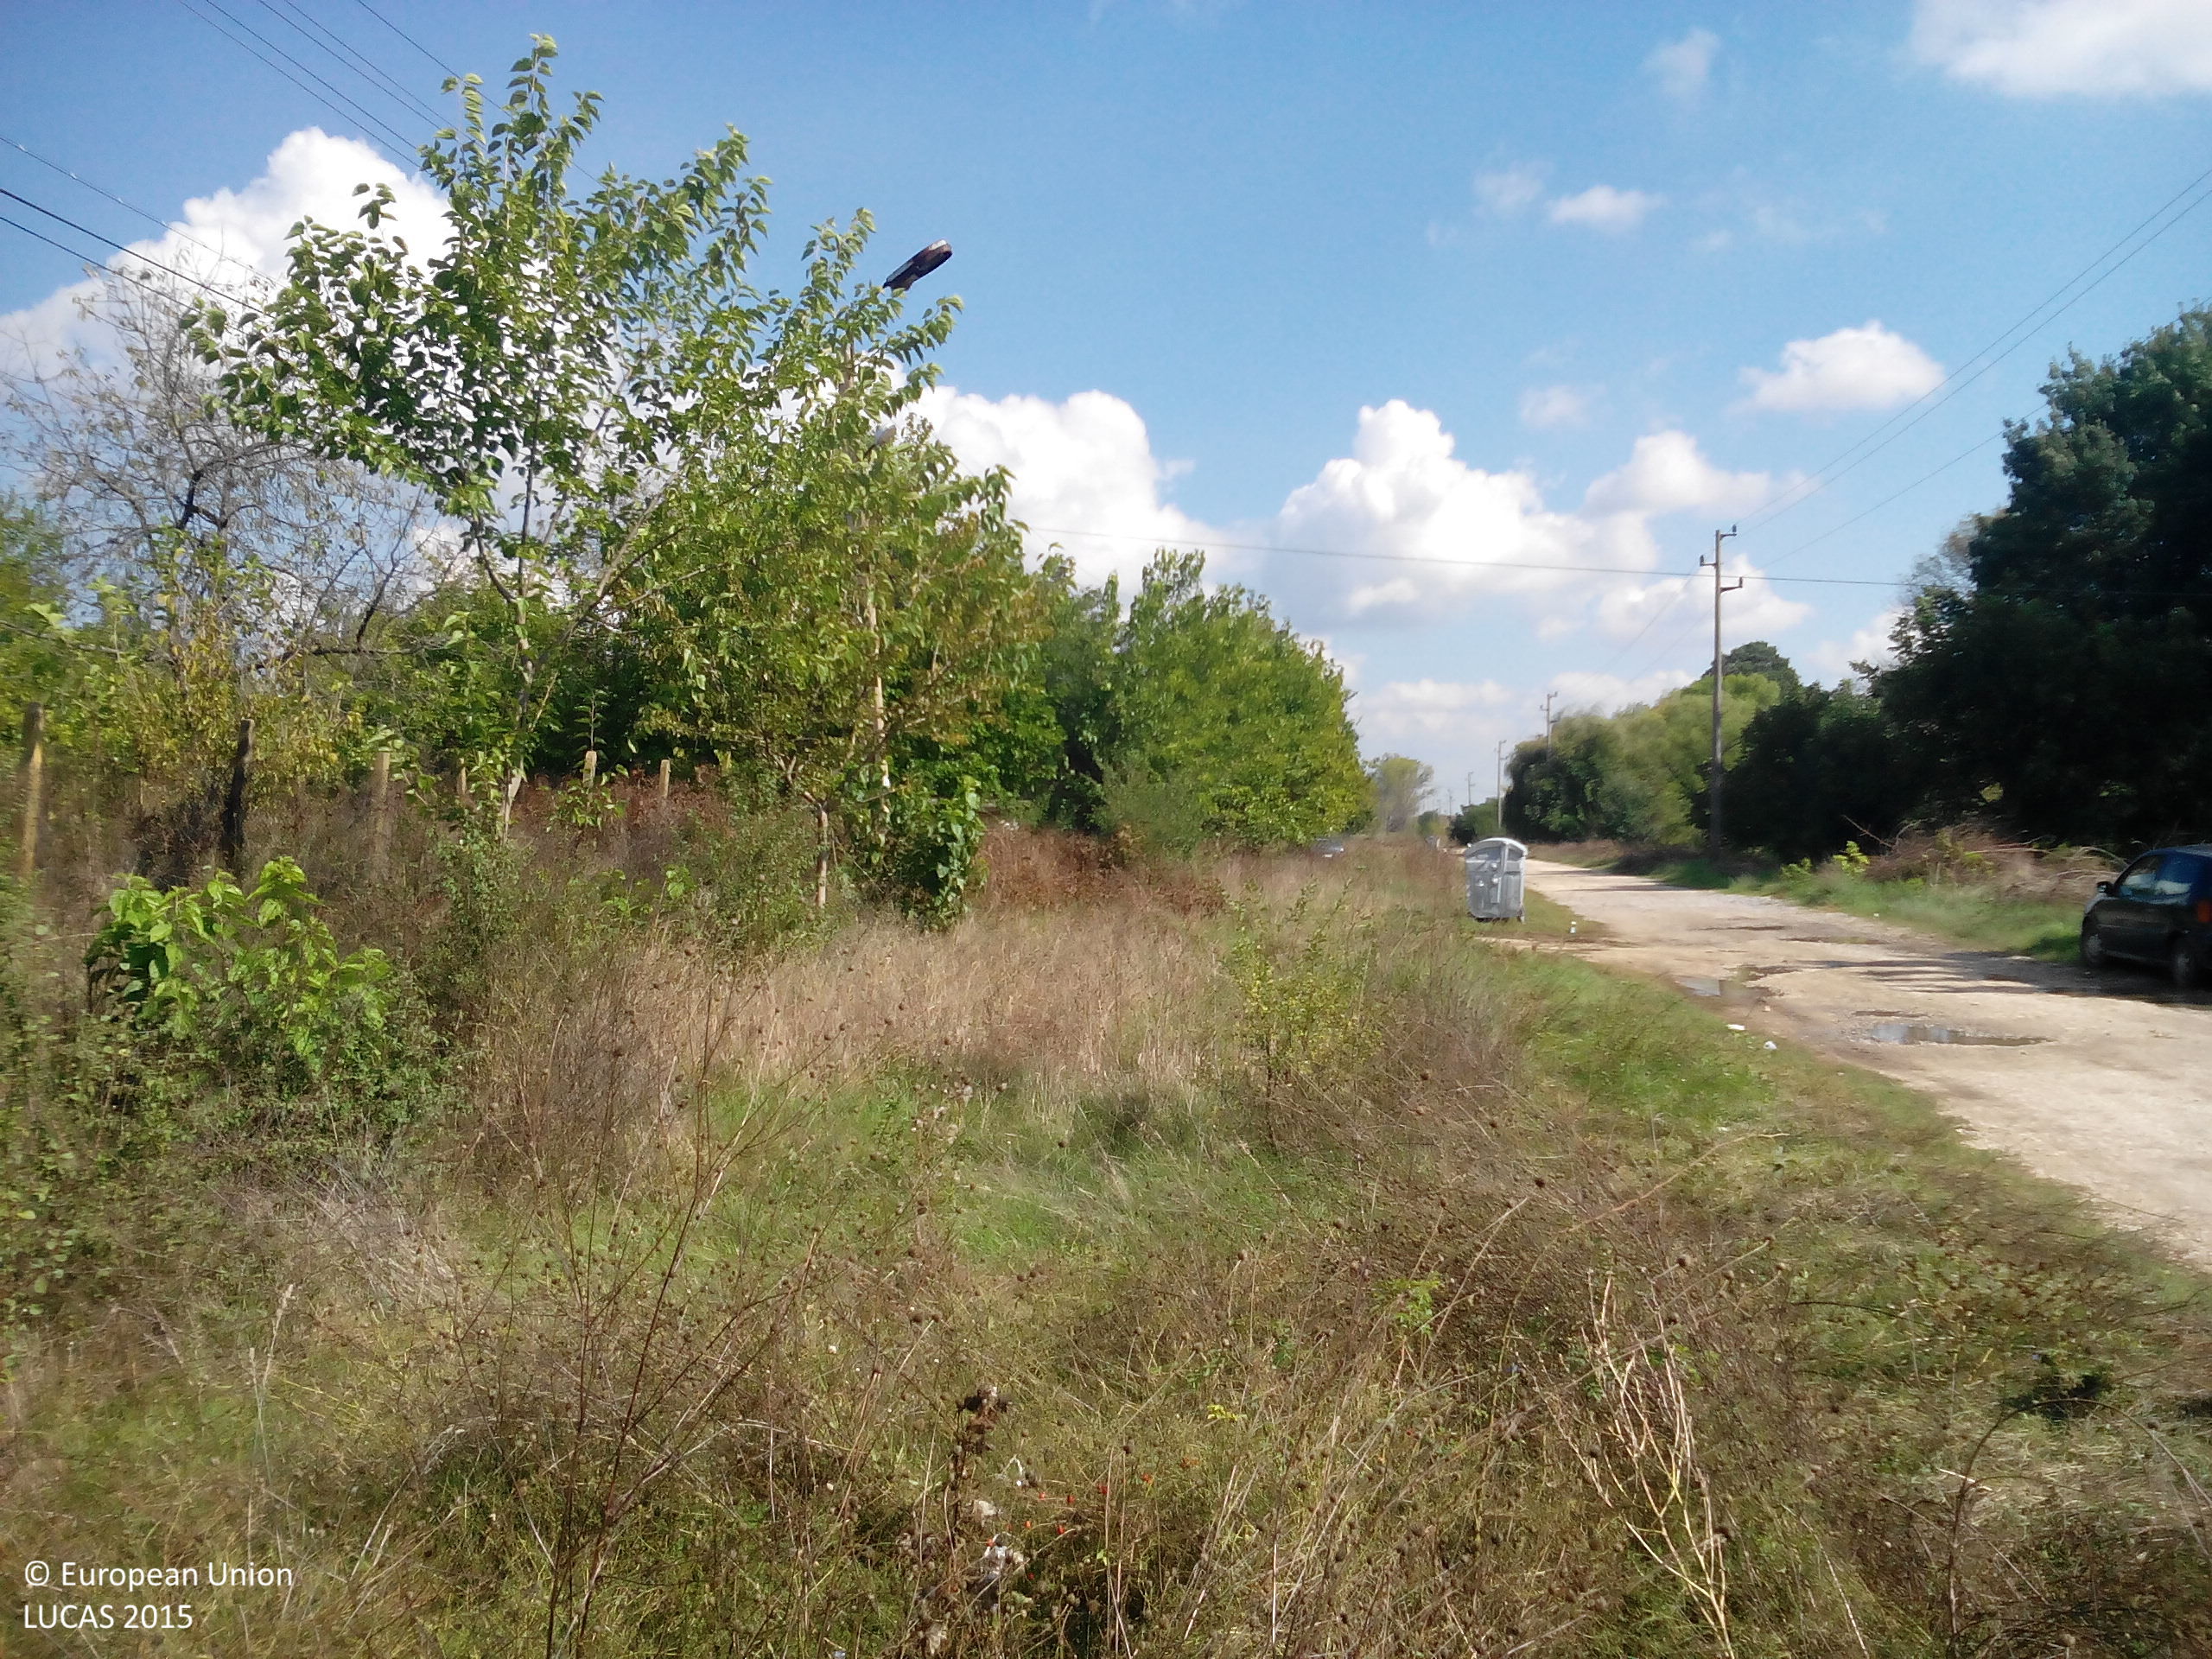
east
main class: Woodland
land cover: Broadleaved woodland
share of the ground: > 75 %
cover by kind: broadleaved forest trees 80 %, shrubs 10 %, herbaceous plants 10 %
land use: Abandoned areas
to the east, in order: Broadleaved woodland; Artificial constructions in urban areas
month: October
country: BG
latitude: 43.4317
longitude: 23.8736
